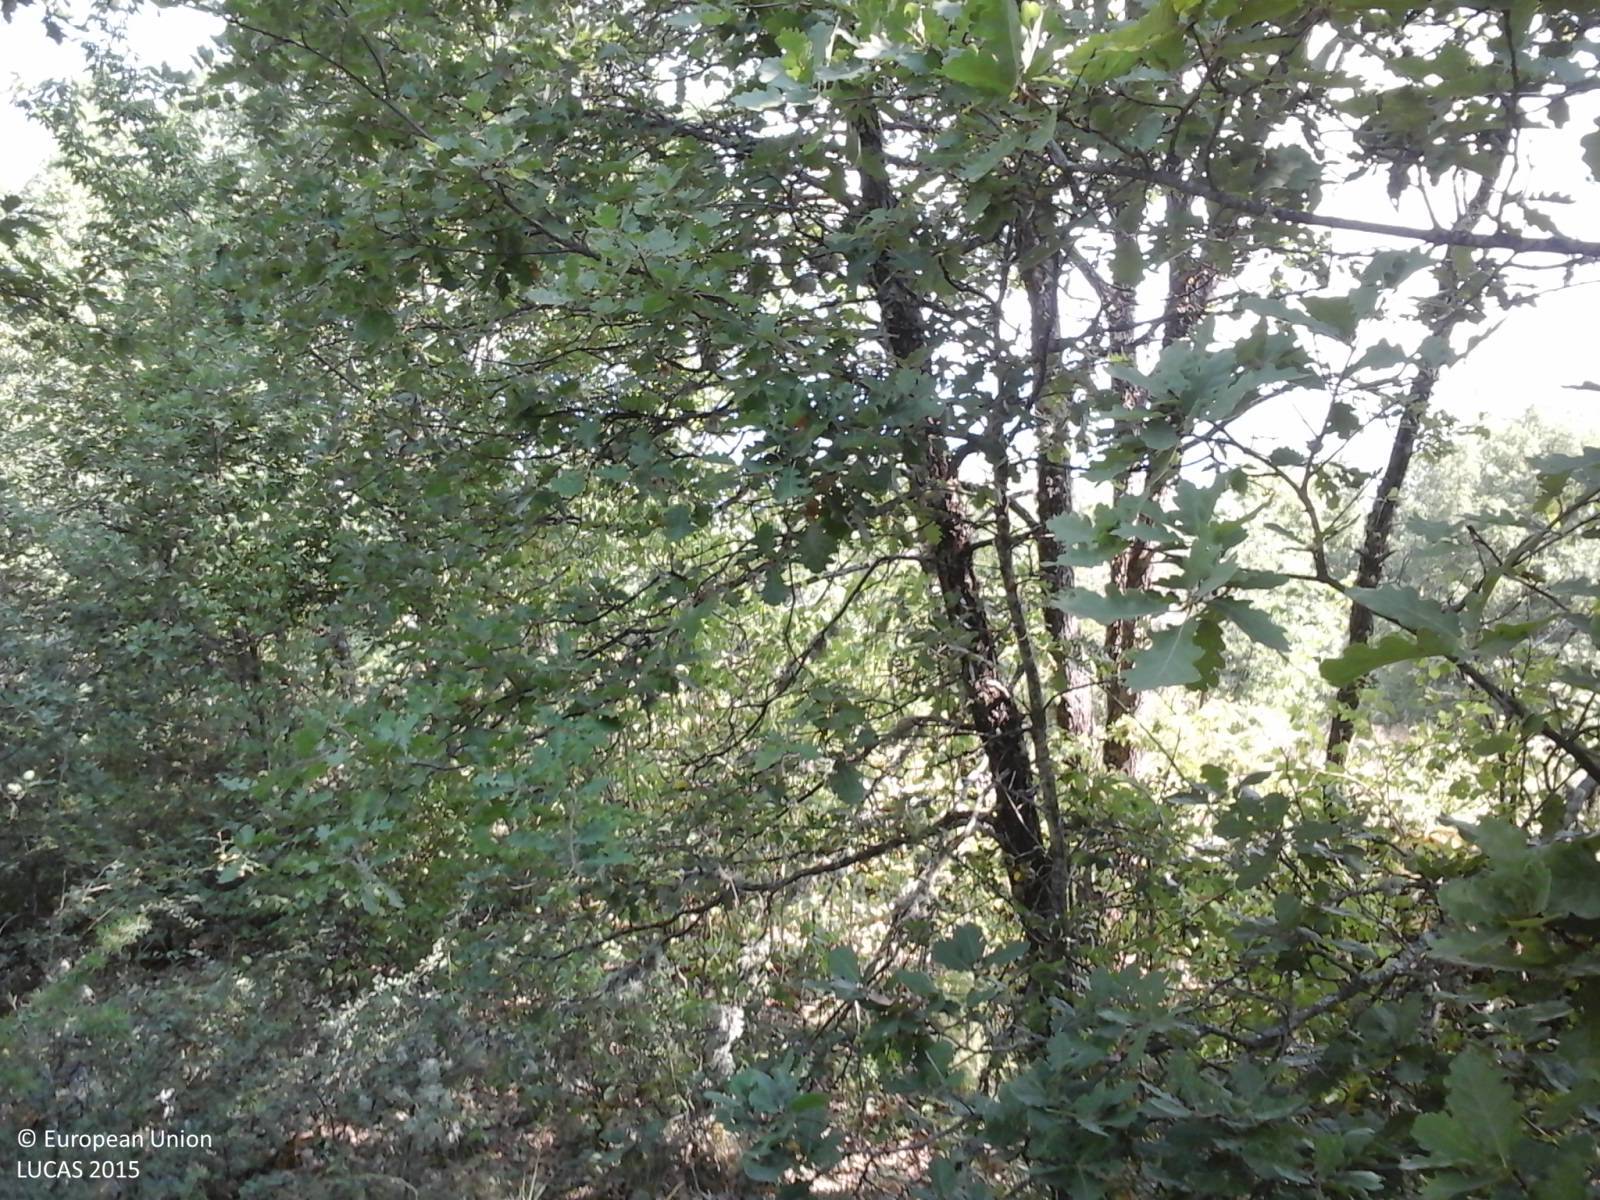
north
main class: Woodland
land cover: Broadleaved woodland
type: thermophilous deciduous forest
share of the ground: > 75 %
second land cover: Grassland without tree/shrub cover
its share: > 75 %
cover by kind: broadleaved forest trees 80 %, shrubs 10 %, herbaceous plants 10 %
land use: Forestry
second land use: Agriculture (excluding fallow land and kitchen gardens)
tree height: > 5 m
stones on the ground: 25 - 50 %
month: July
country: IT
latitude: 42.3463
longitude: 13.3274
